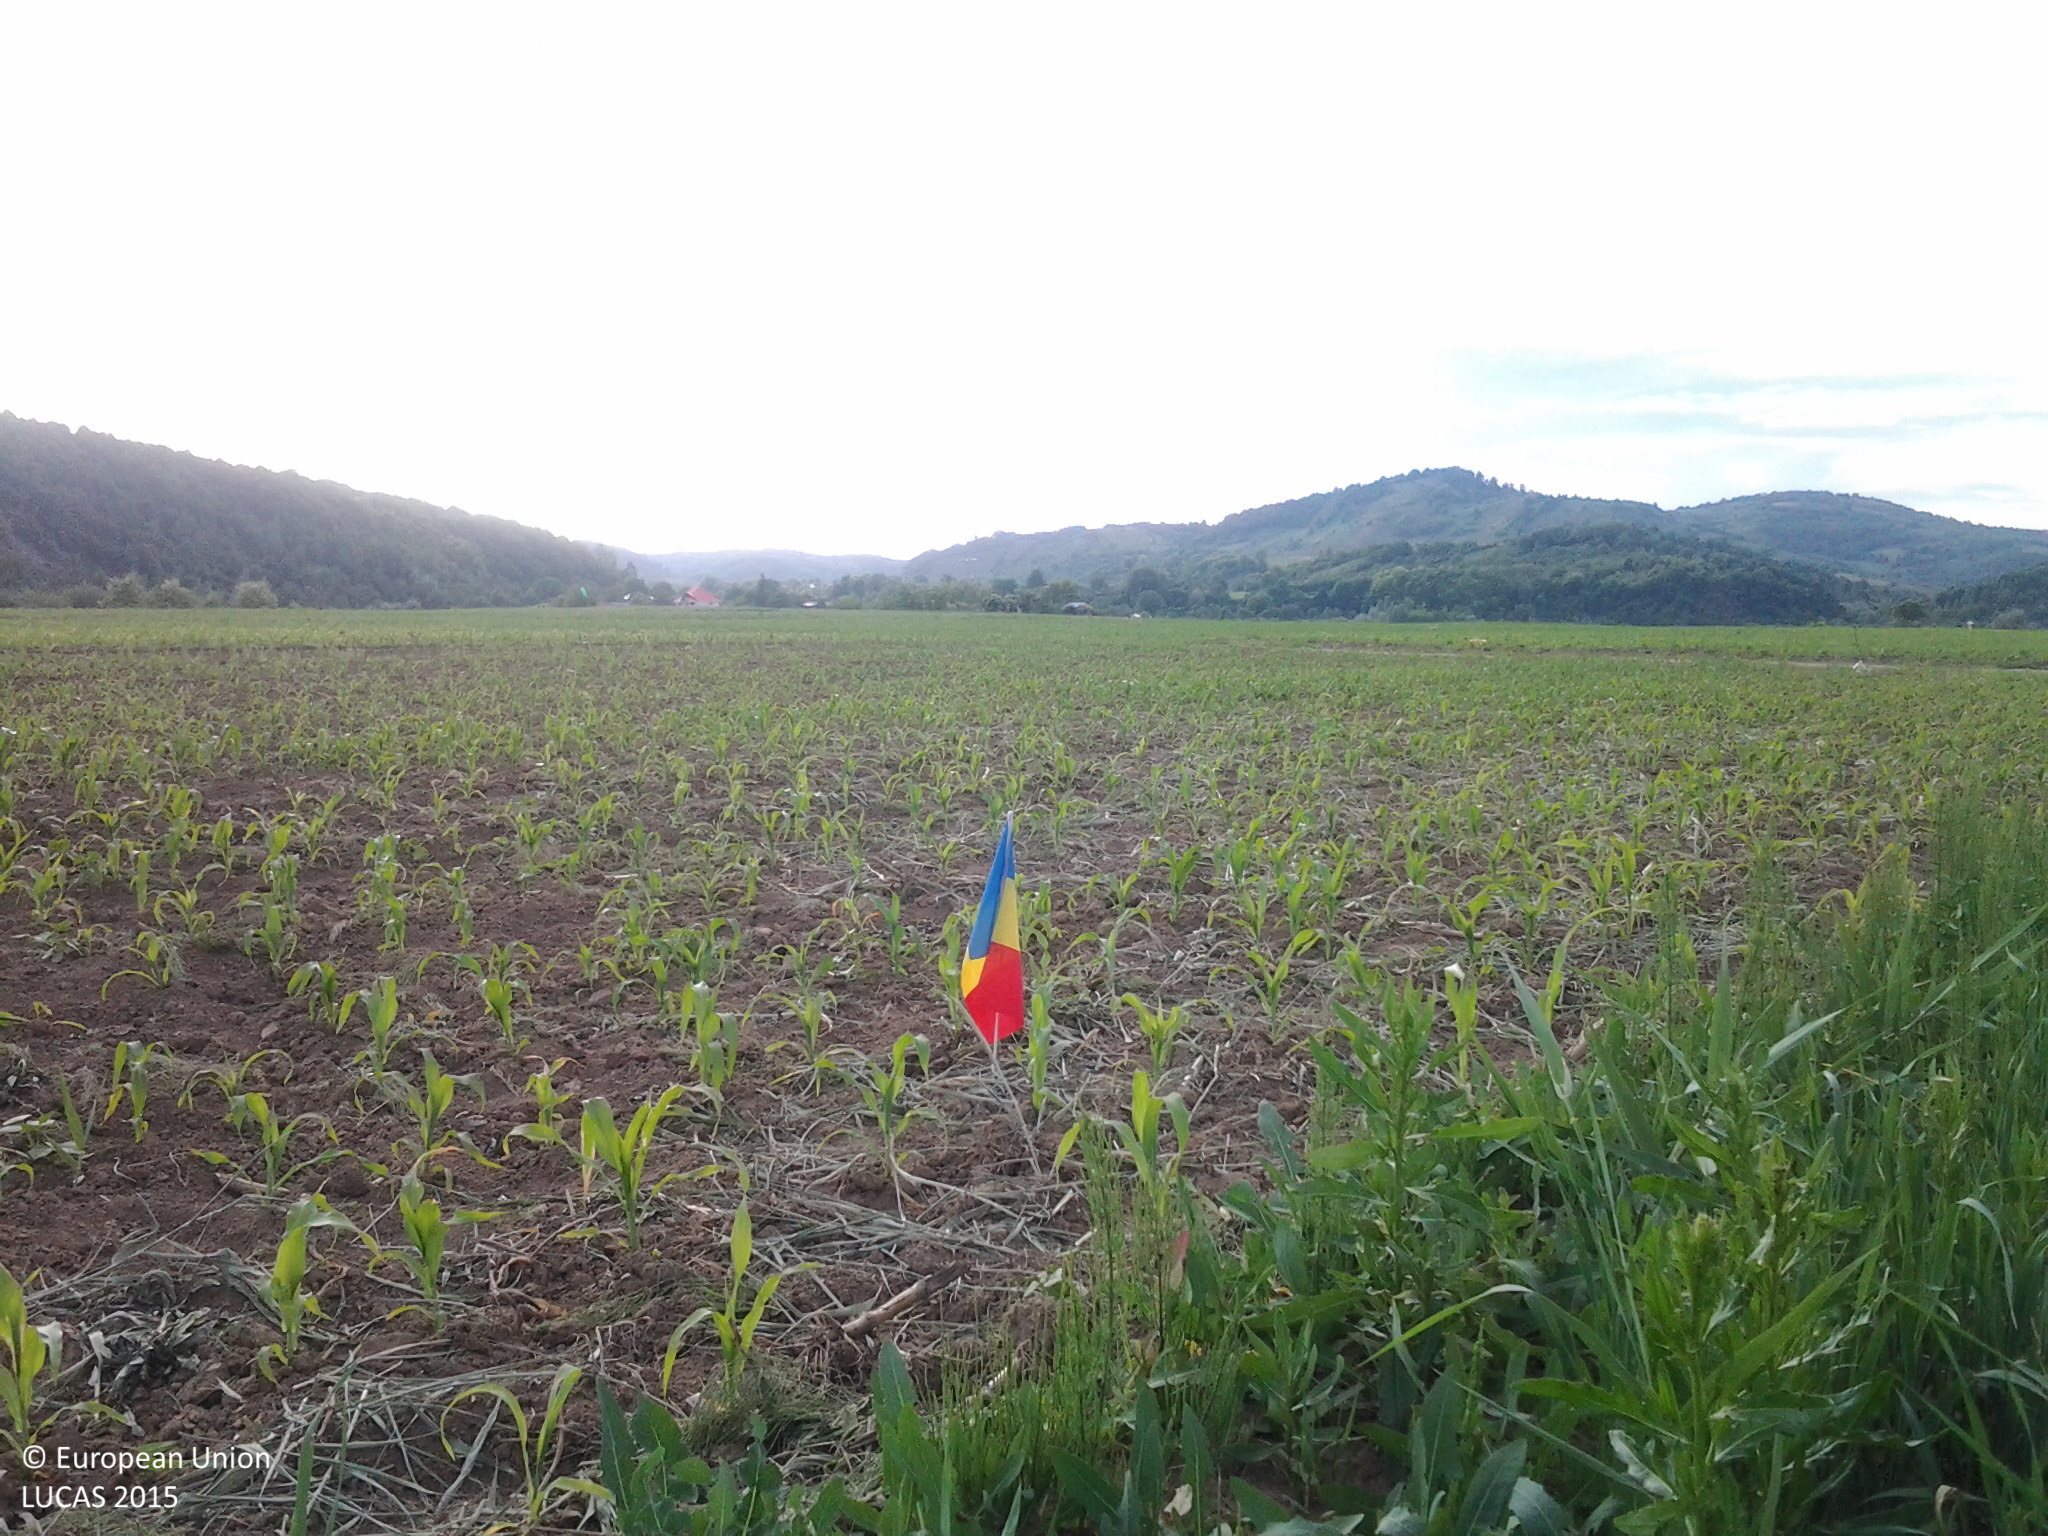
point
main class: Cropland
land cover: Maize
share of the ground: < 10 %
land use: Agriculture (excluding fallow land and kitchen gardens)
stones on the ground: < 10 %
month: June
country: RO
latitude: 46.3836
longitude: 26.7173
